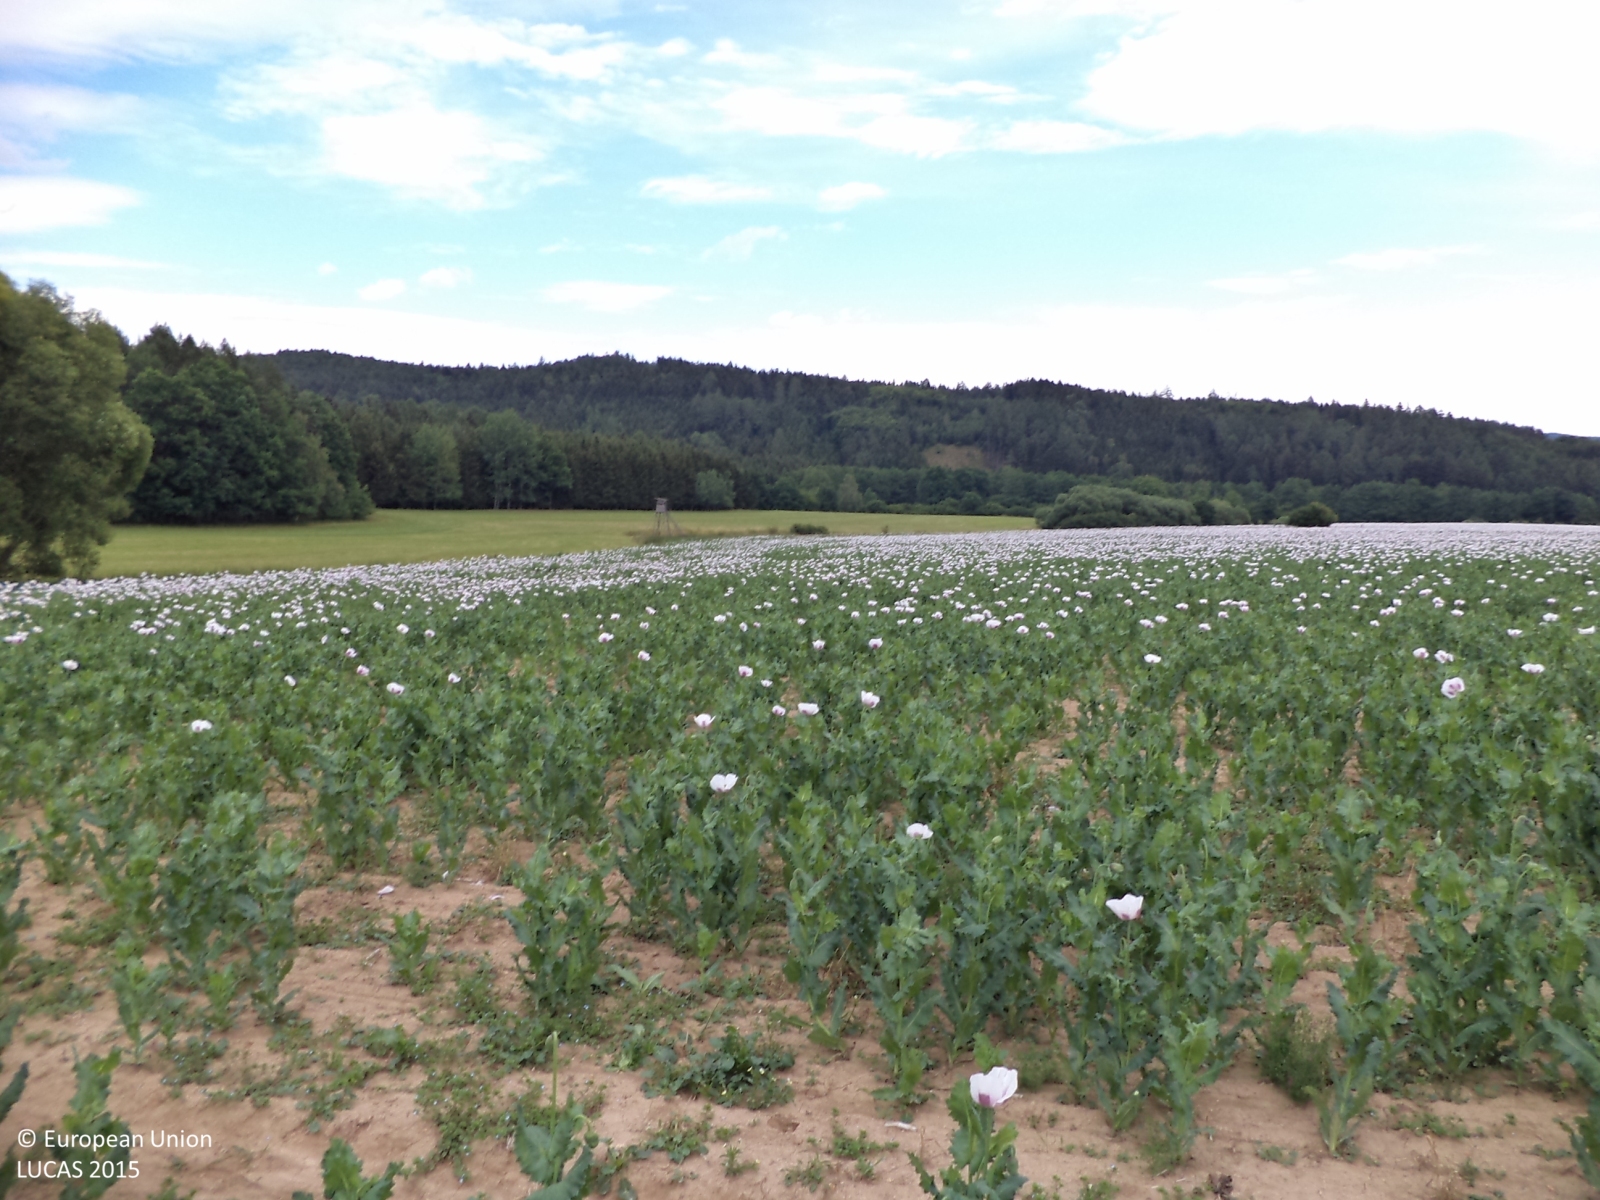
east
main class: Cropland
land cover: Other fibre and oleaginous crops
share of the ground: 50 - 75 %
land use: Agriculture (excluding fallow land and kitchen gardens)
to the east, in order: Other fibre and oleaginous crops; Tracks; Other fibre and oleaginous crops; Grassland without tree/shrub cover
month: June
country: CZ
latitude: 49.6505
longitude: 14.8083
